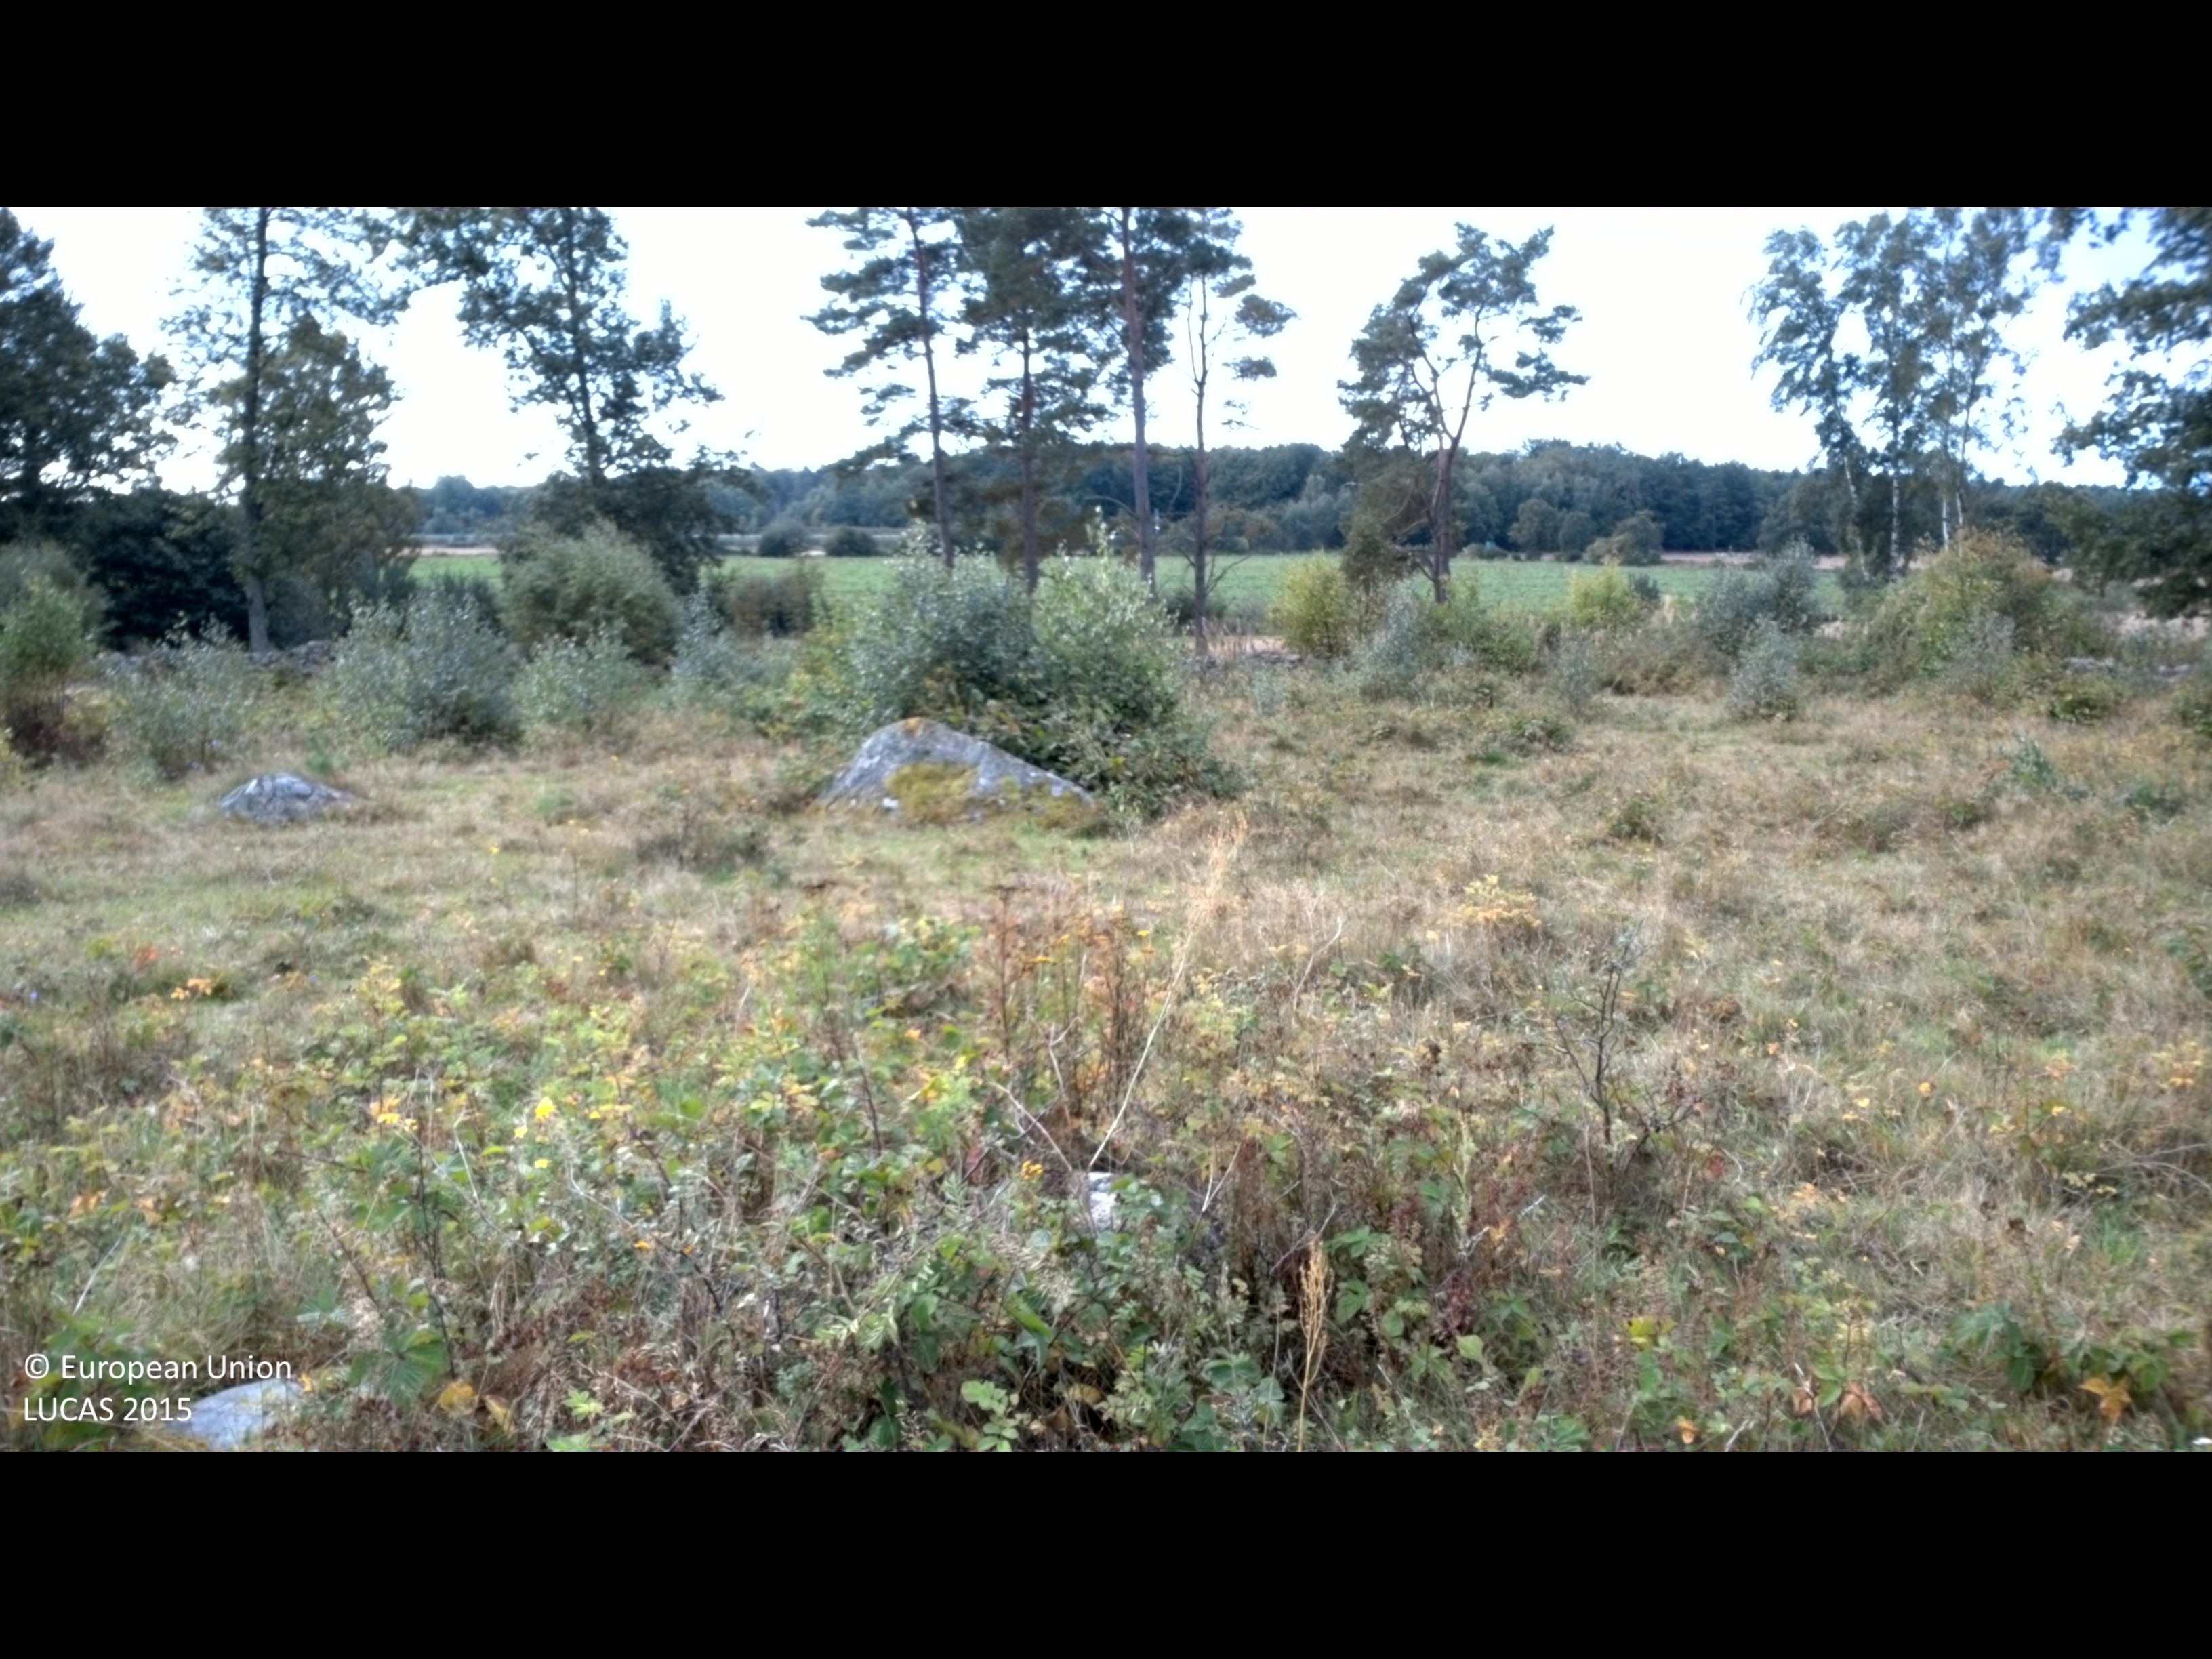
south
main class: Grassland
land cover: Grassland without tree/shrub cover
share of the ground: > 75 %
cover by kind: herbaceous plants 95 %, shrubs 5 %
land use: Agriculture (excluding fallow land and kitchen gardens)
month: September
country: SE
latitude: 56.0702
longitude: 14.5765
